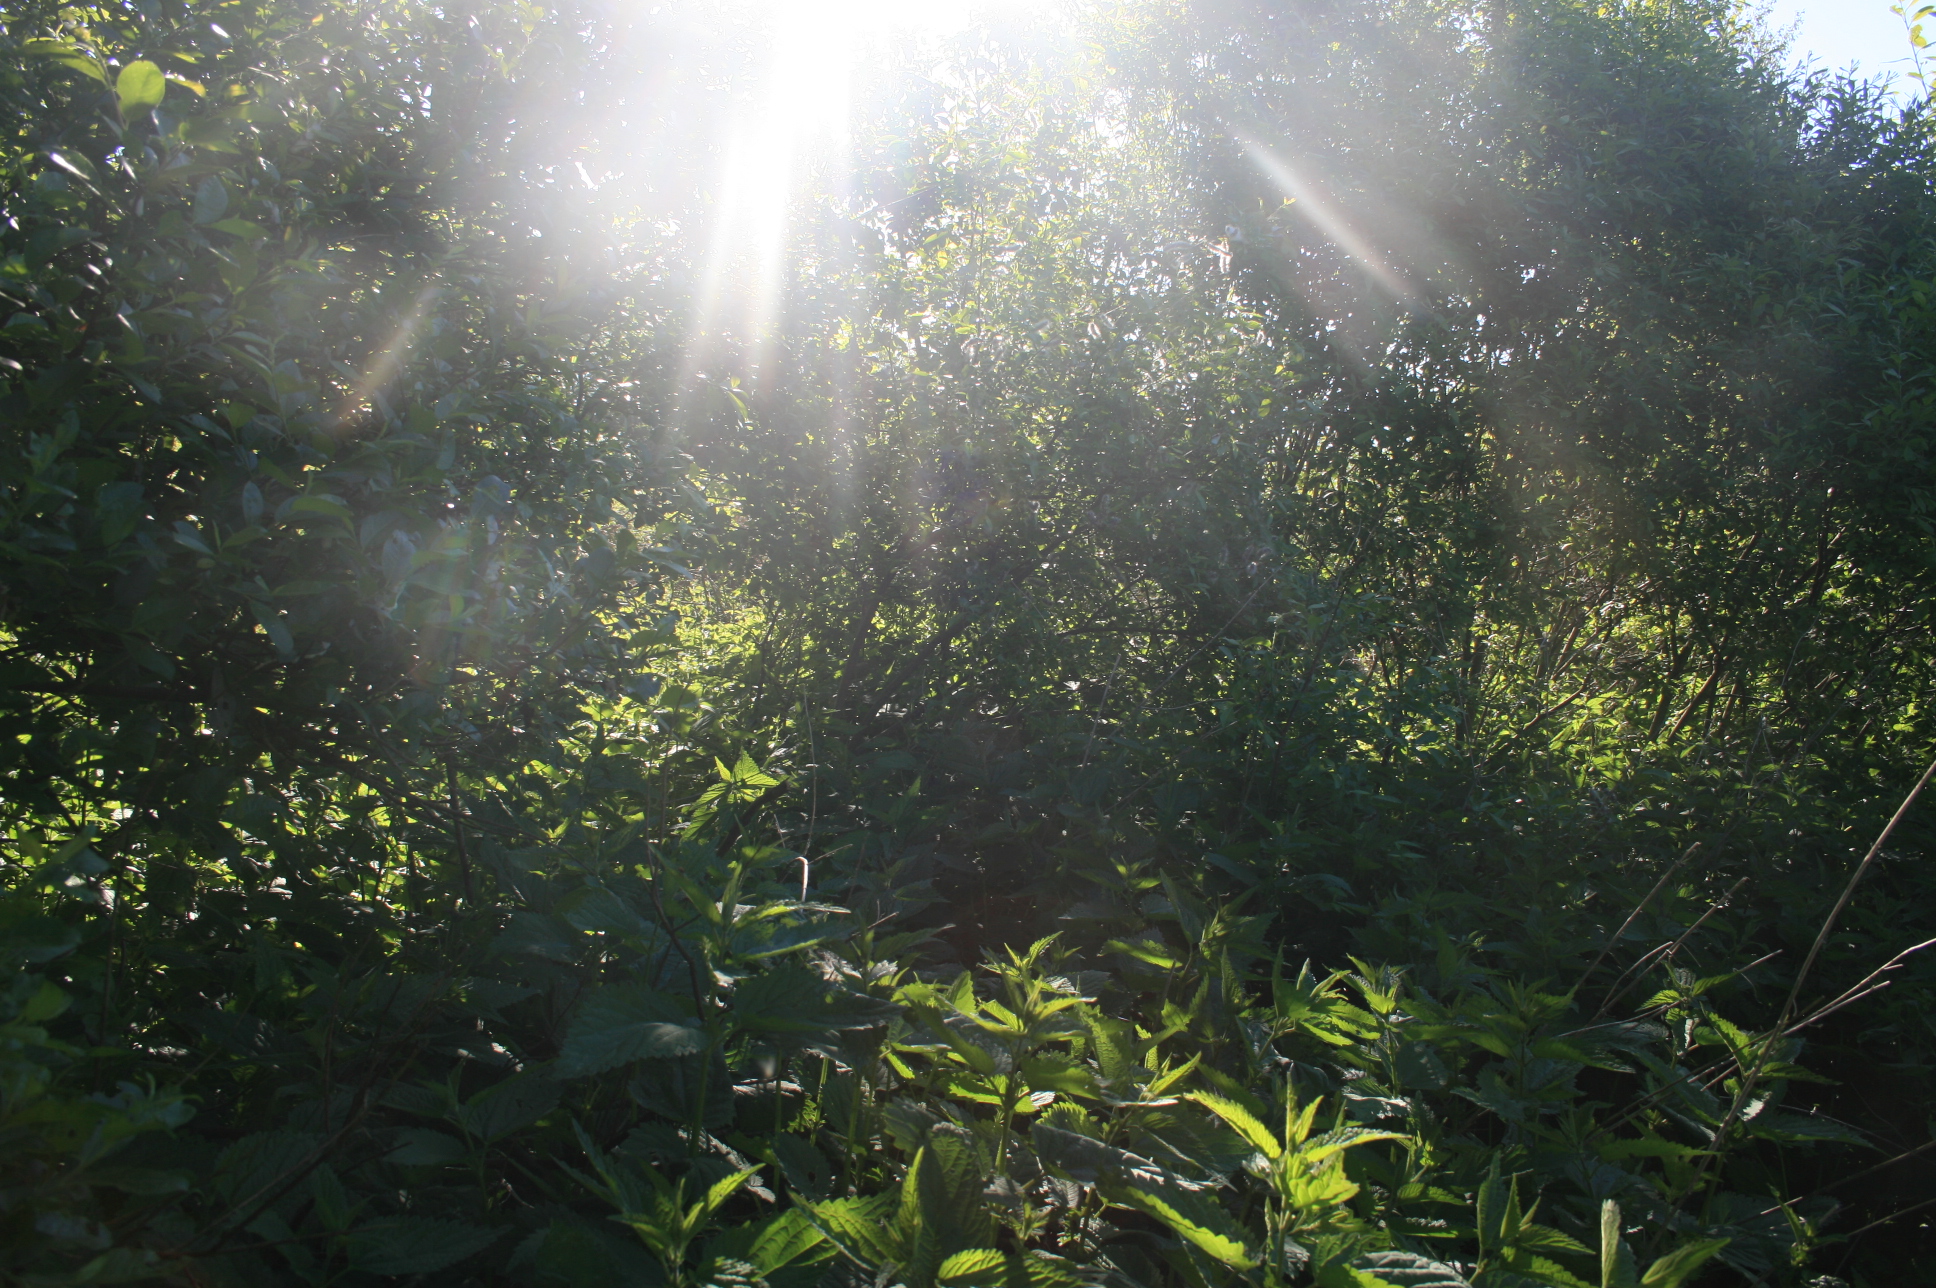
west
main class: Woodland
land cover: Broadleaved woodland
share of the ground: > 75 %
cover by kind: broadleaved forest trees 95 %, herbaceous plants 5 %
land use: Semi-natural and natural areas not in use
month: June
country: LT
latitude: 55.5825
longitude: 22.2239
